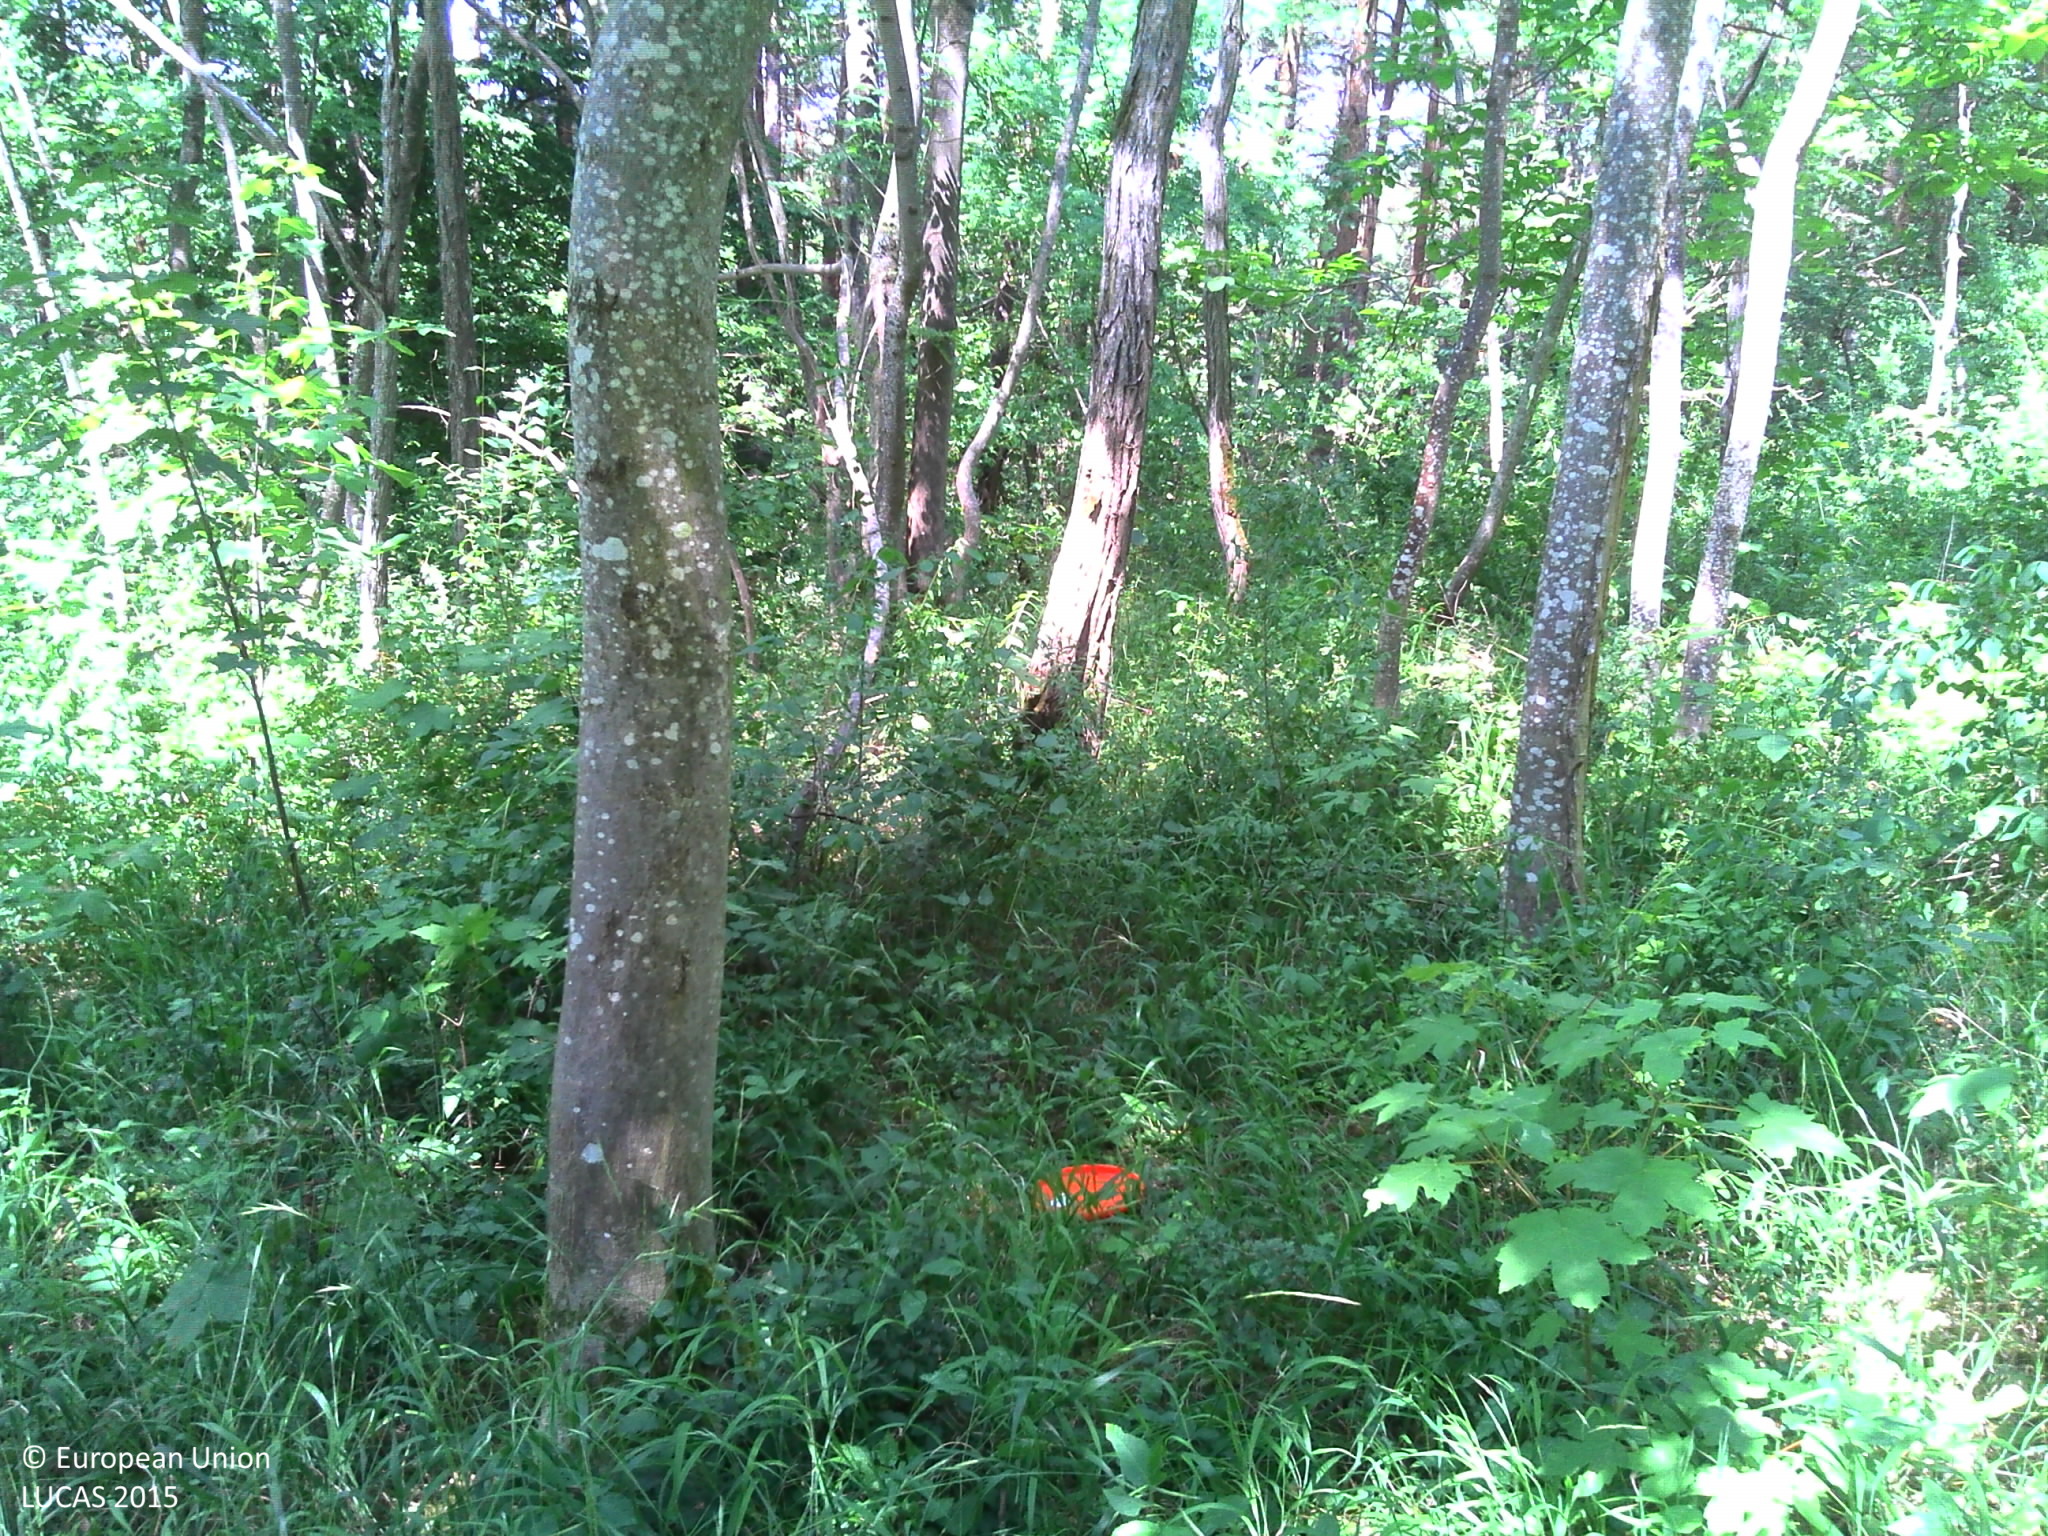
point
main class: Woodland
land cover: Broadleaved woodland
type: mesophytic deciduous forest
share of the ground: > 75 %
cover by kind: broadleaved forest trees 85 %, herbaceous plants 15 %
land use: Forestry
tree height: > 5 m
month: July
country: FR
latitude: 48.5545
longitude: 7.4673
